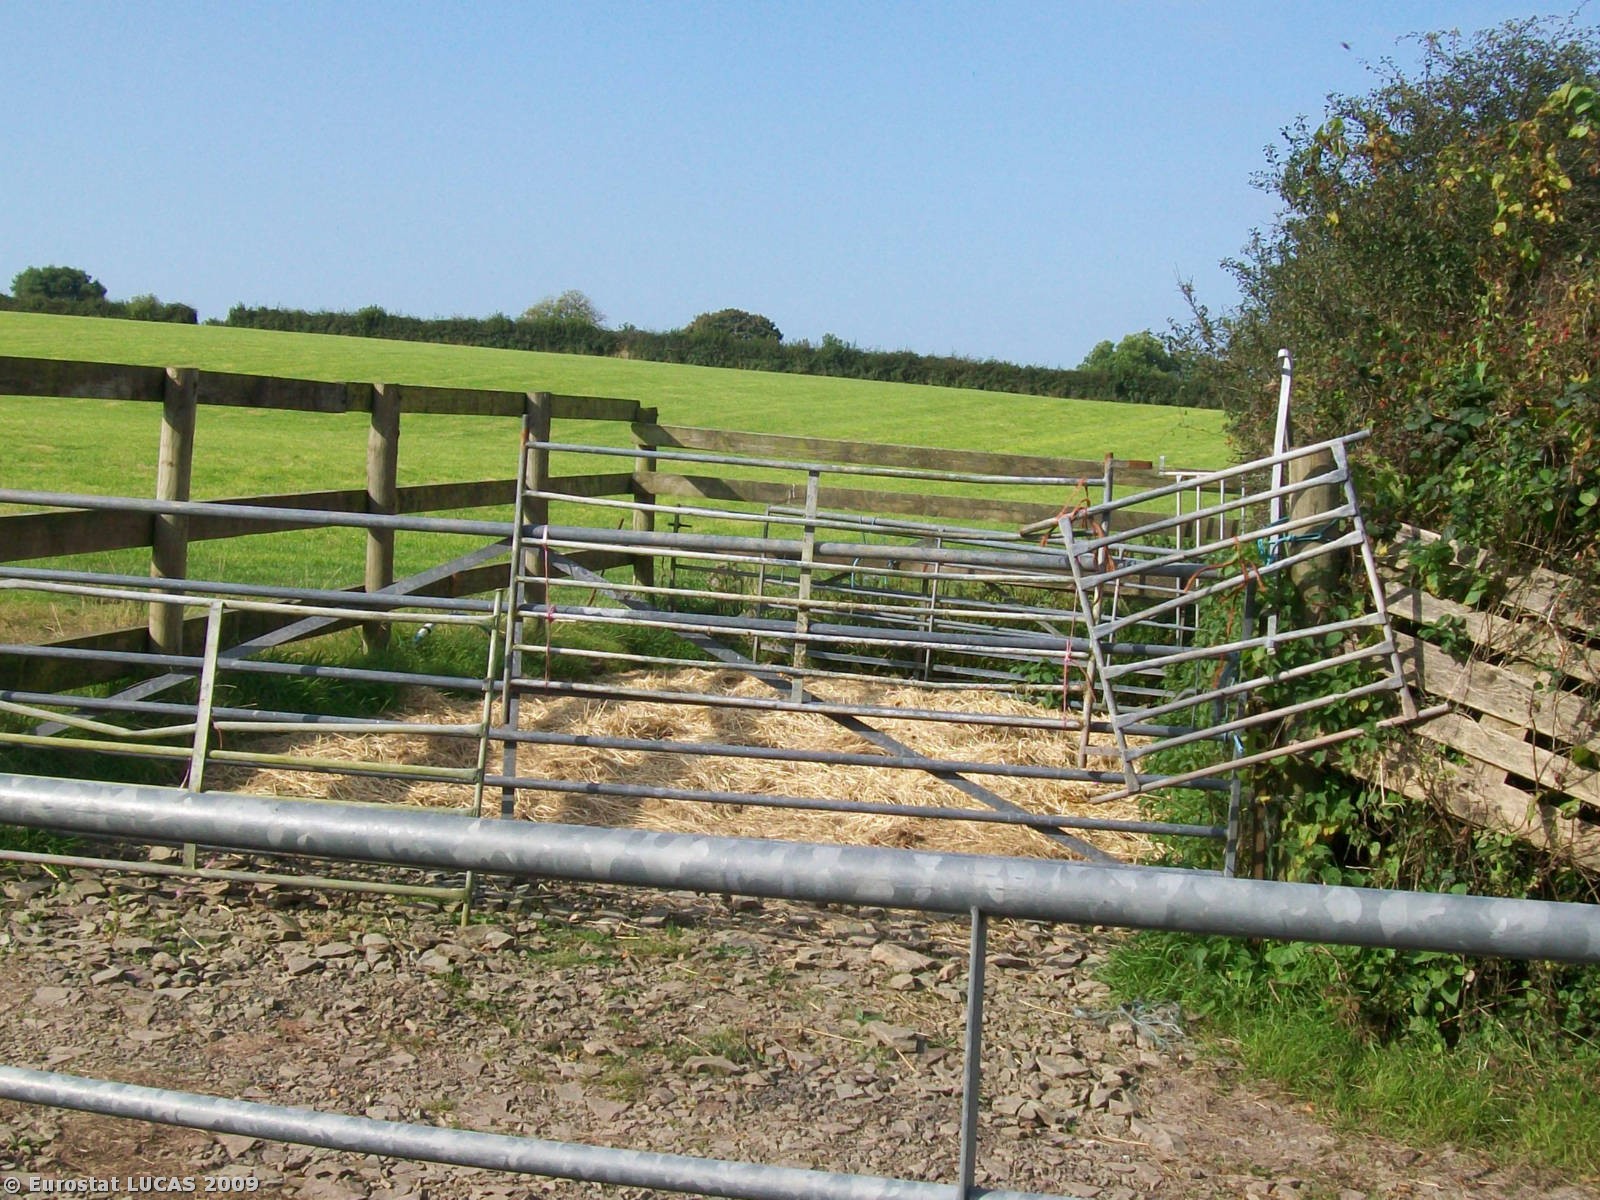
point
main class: Grassland
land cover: Grassland without tree/shrub cover
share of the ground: > 75 %
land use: Agriculture (excluding fallow land and kitchen gardens)
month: September
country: GB
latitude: 51.7836
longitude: -4.7076
